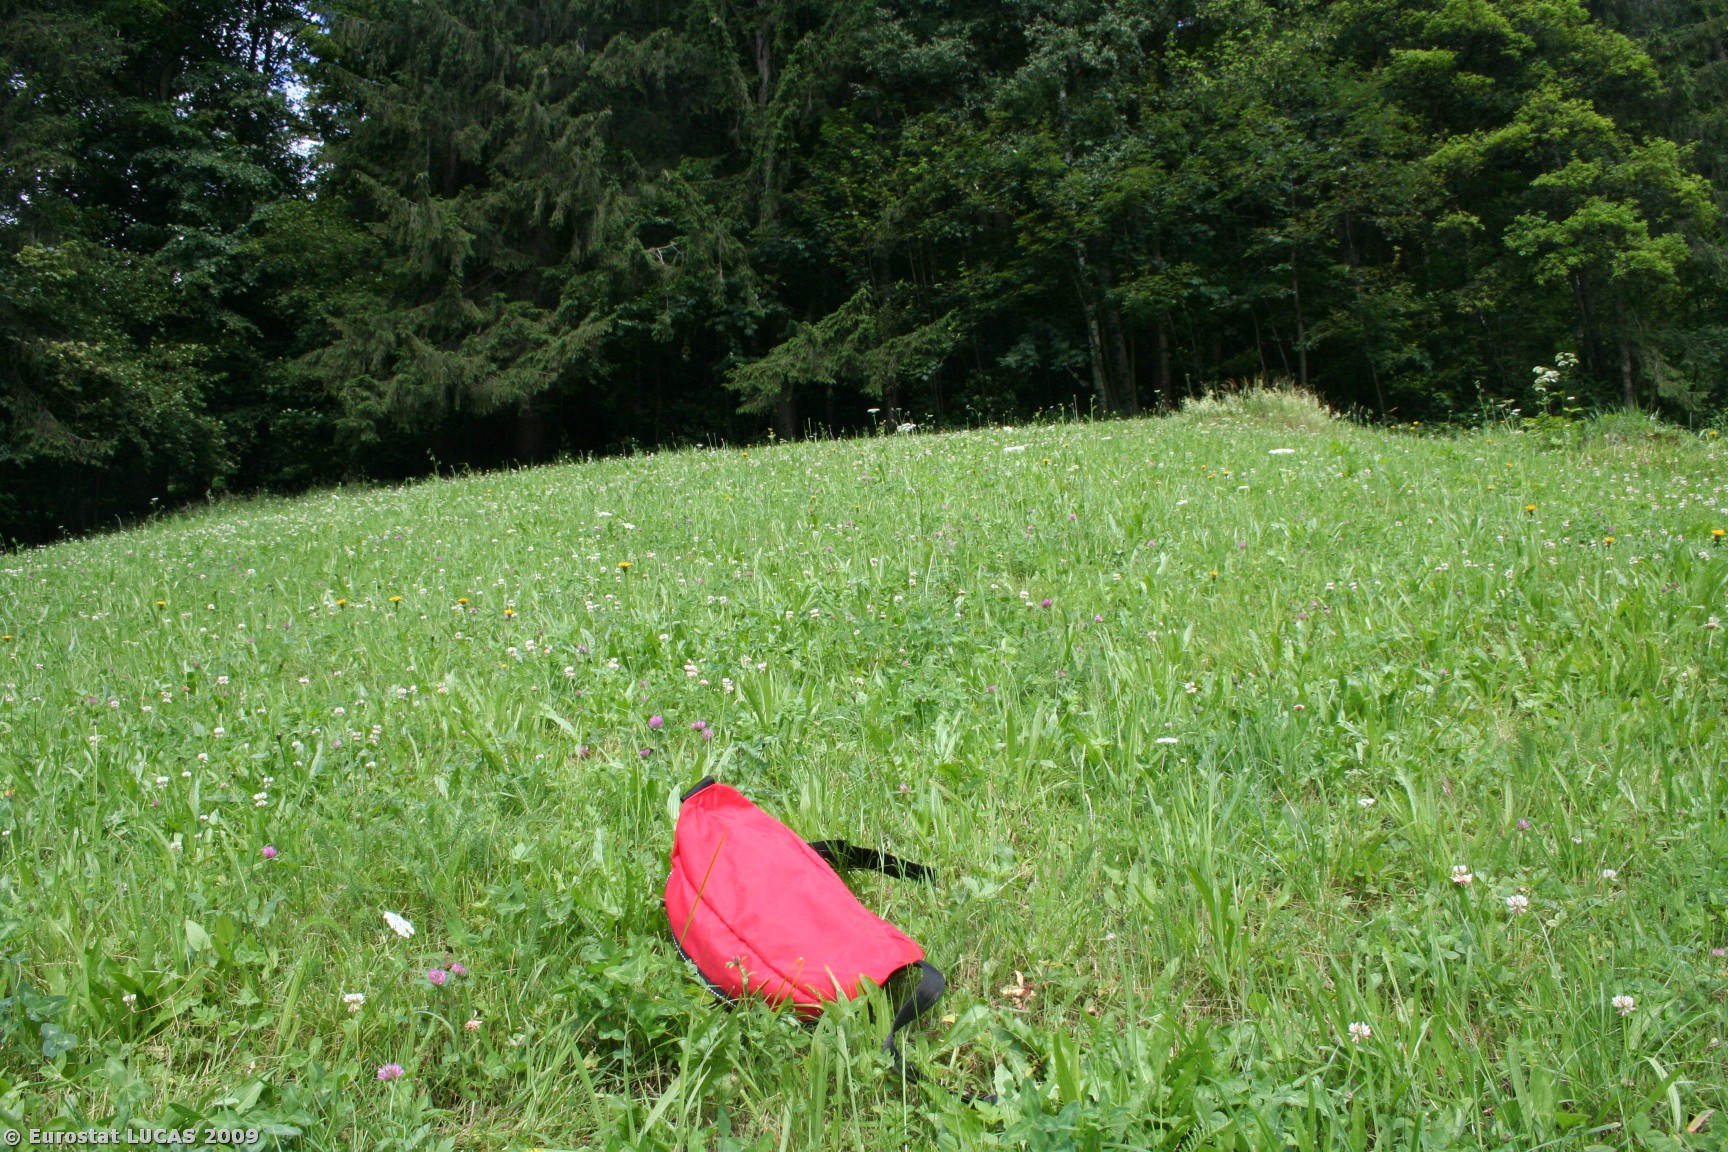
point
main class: Grassland
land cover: Grassland without tree/shrub cover
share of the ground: > 75 %
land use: Agriculture (excluding fallow land and kitchen gardens)
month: June
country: AT
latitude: 47.1996
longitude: 11.8596
